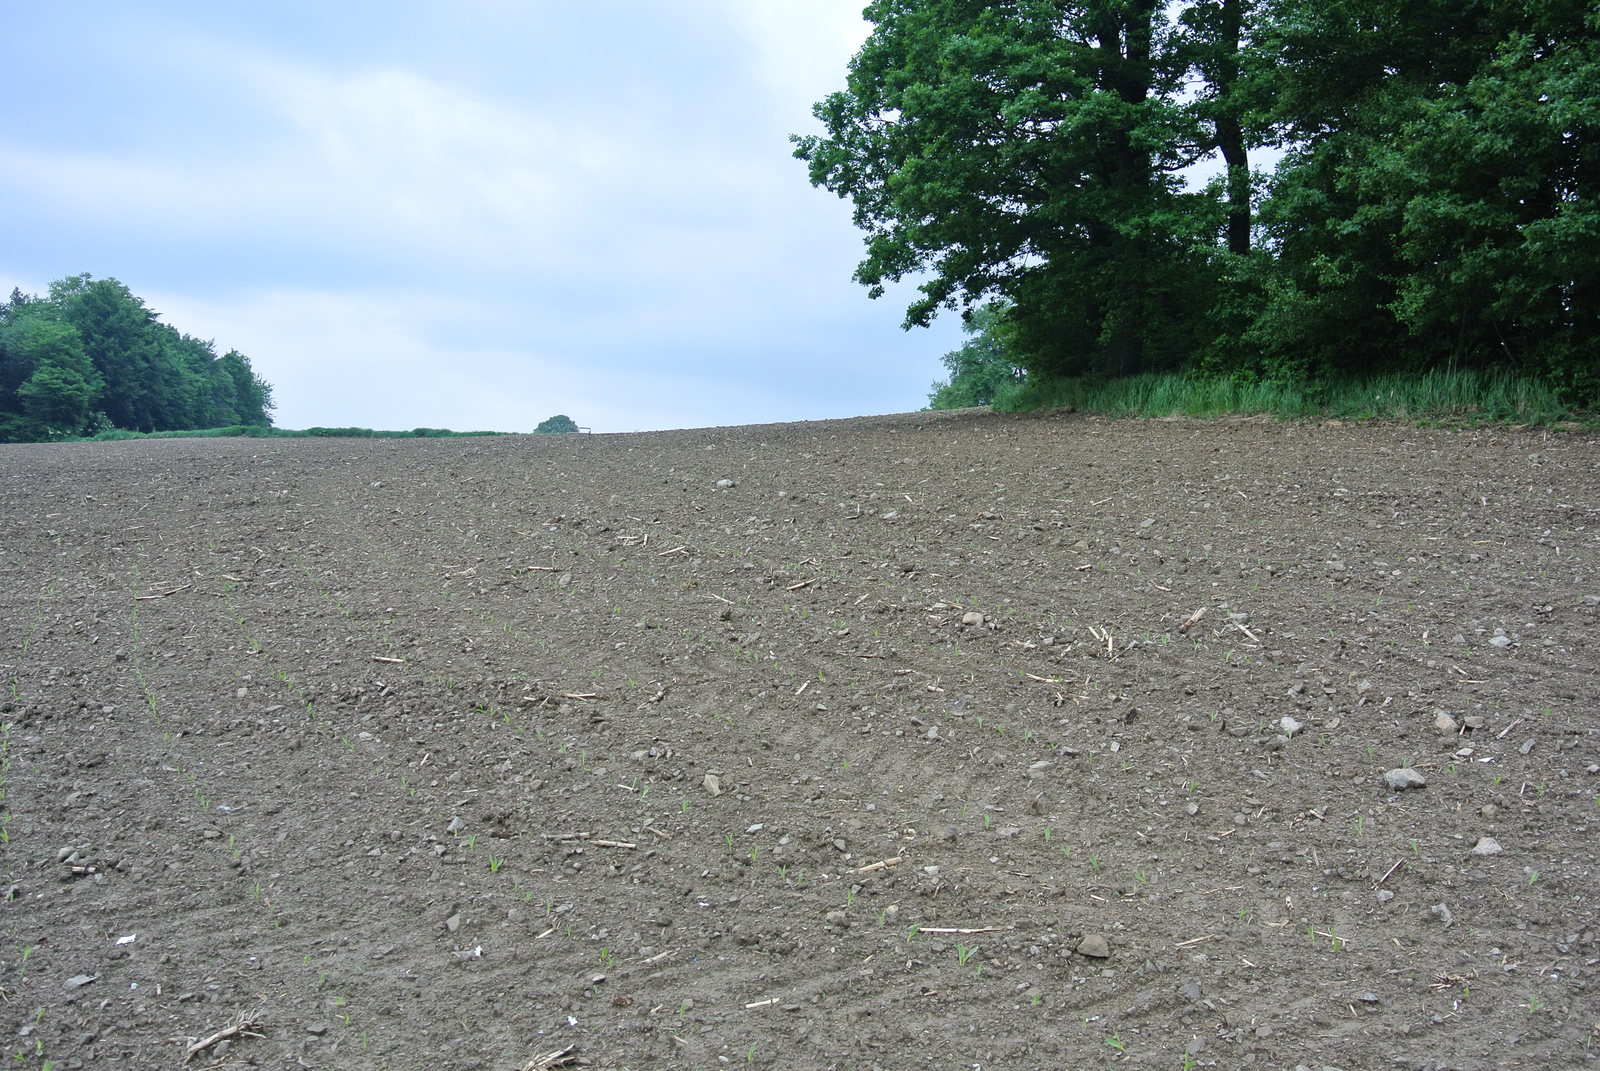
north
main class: Cropland
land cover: Maize
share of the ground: < 10 %
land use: Agriculture (excluding fallow land and kitchen gardens)
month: May
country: AT
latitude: 48.1046
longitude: 15.8450
